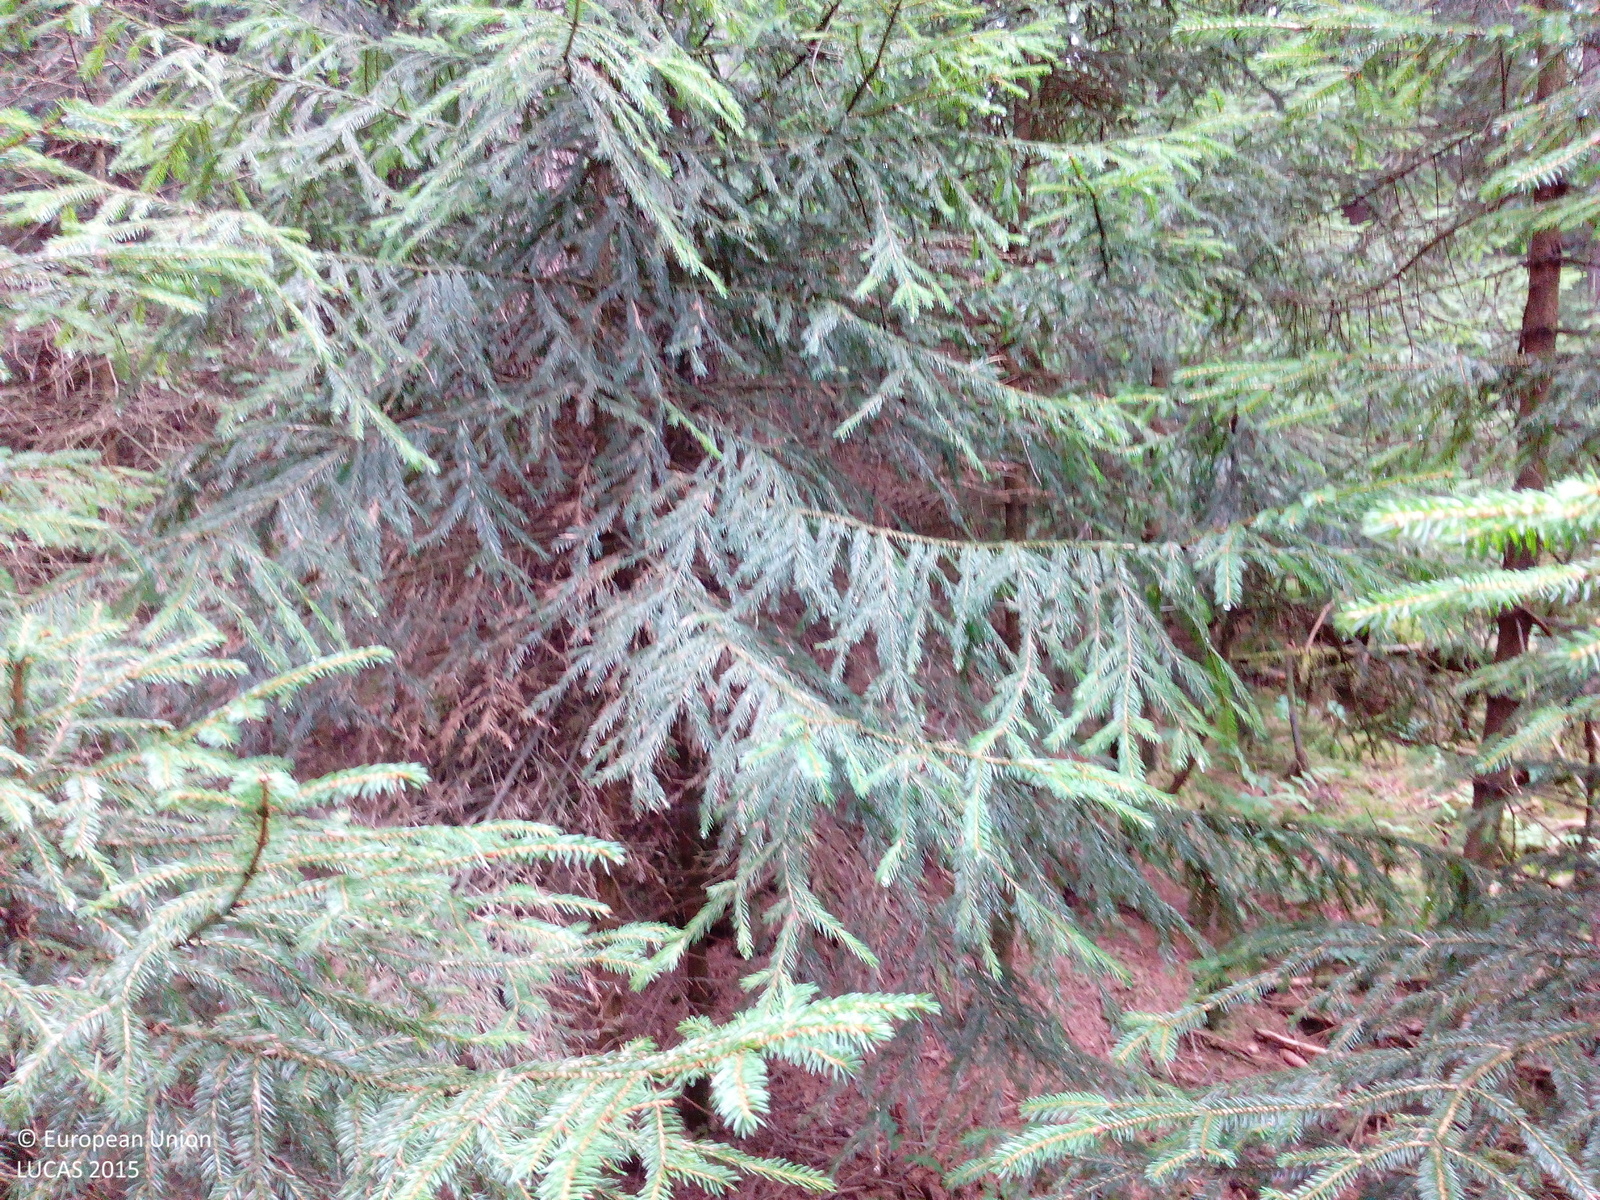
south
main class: Woodland
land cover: Spruce dominated coniferous woodland
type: boreal forest
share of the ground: > 75 %
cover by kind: coniferous forest trees 95 %, lichens and mosses 5 %
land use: Forestry
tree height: > 5 m
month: August
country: DE
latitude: 50.3343
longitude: 11.6433
